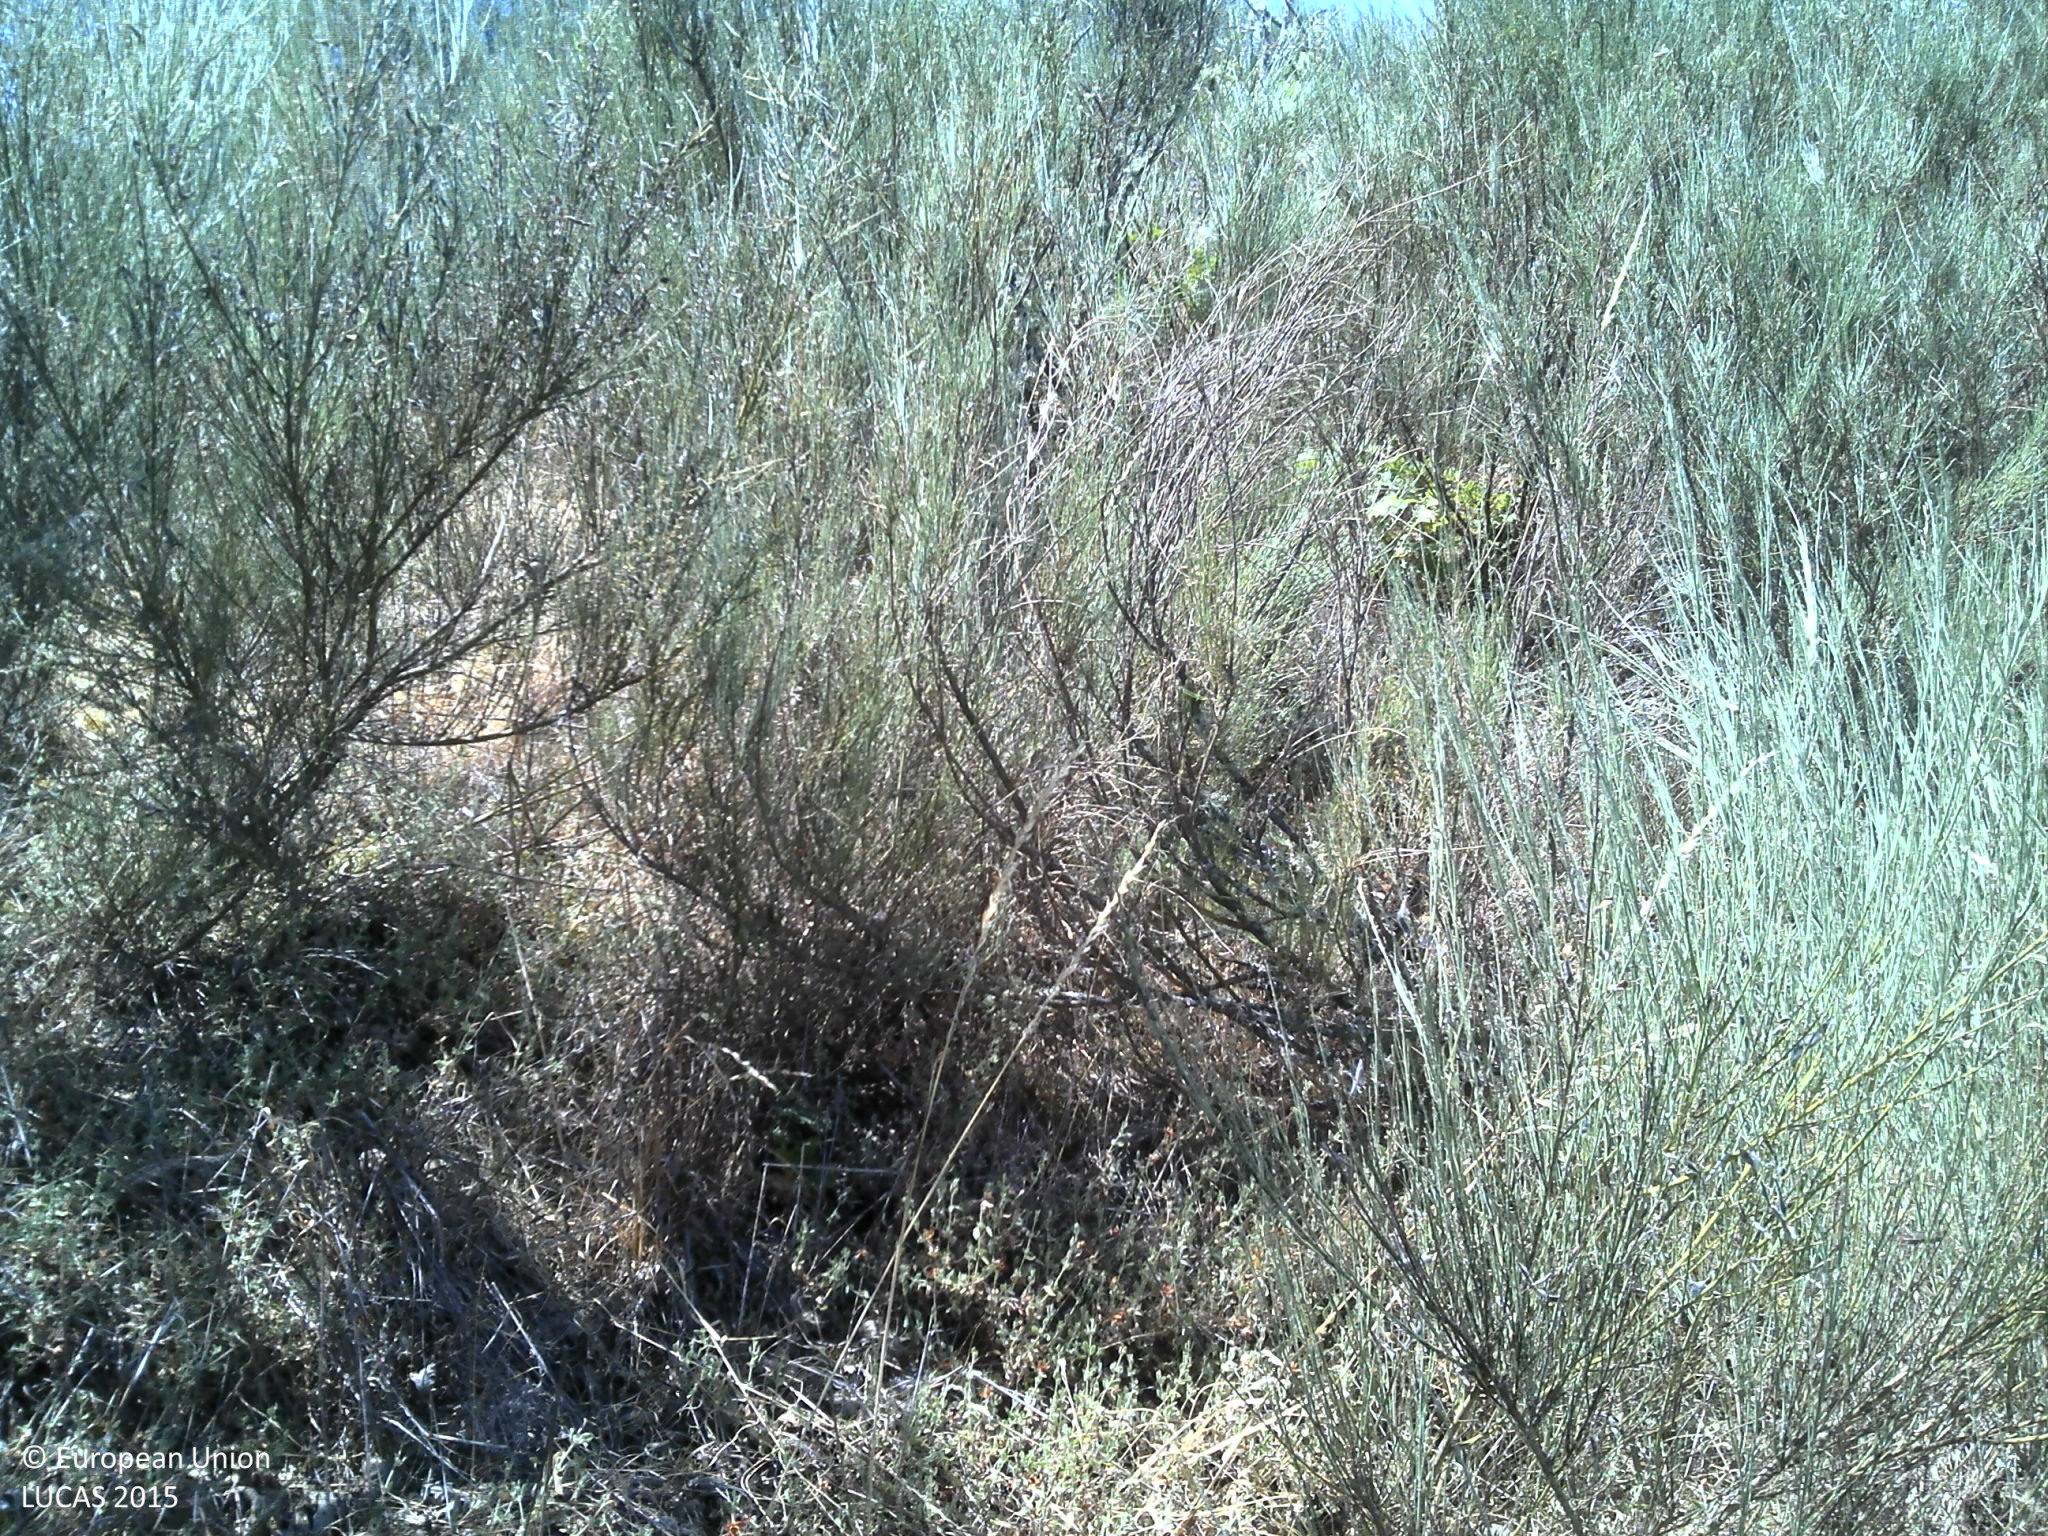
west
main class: Shrubland
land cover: Shrubland without tree cover
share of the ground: > 75 %
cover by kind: shrubs 90 %, herbaceous plants 5 %, unconsolidated bare surface 5 %
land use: Semi-natural and natural areas not in use
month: July
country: PT
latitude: 41.7835
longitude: -7.7905
